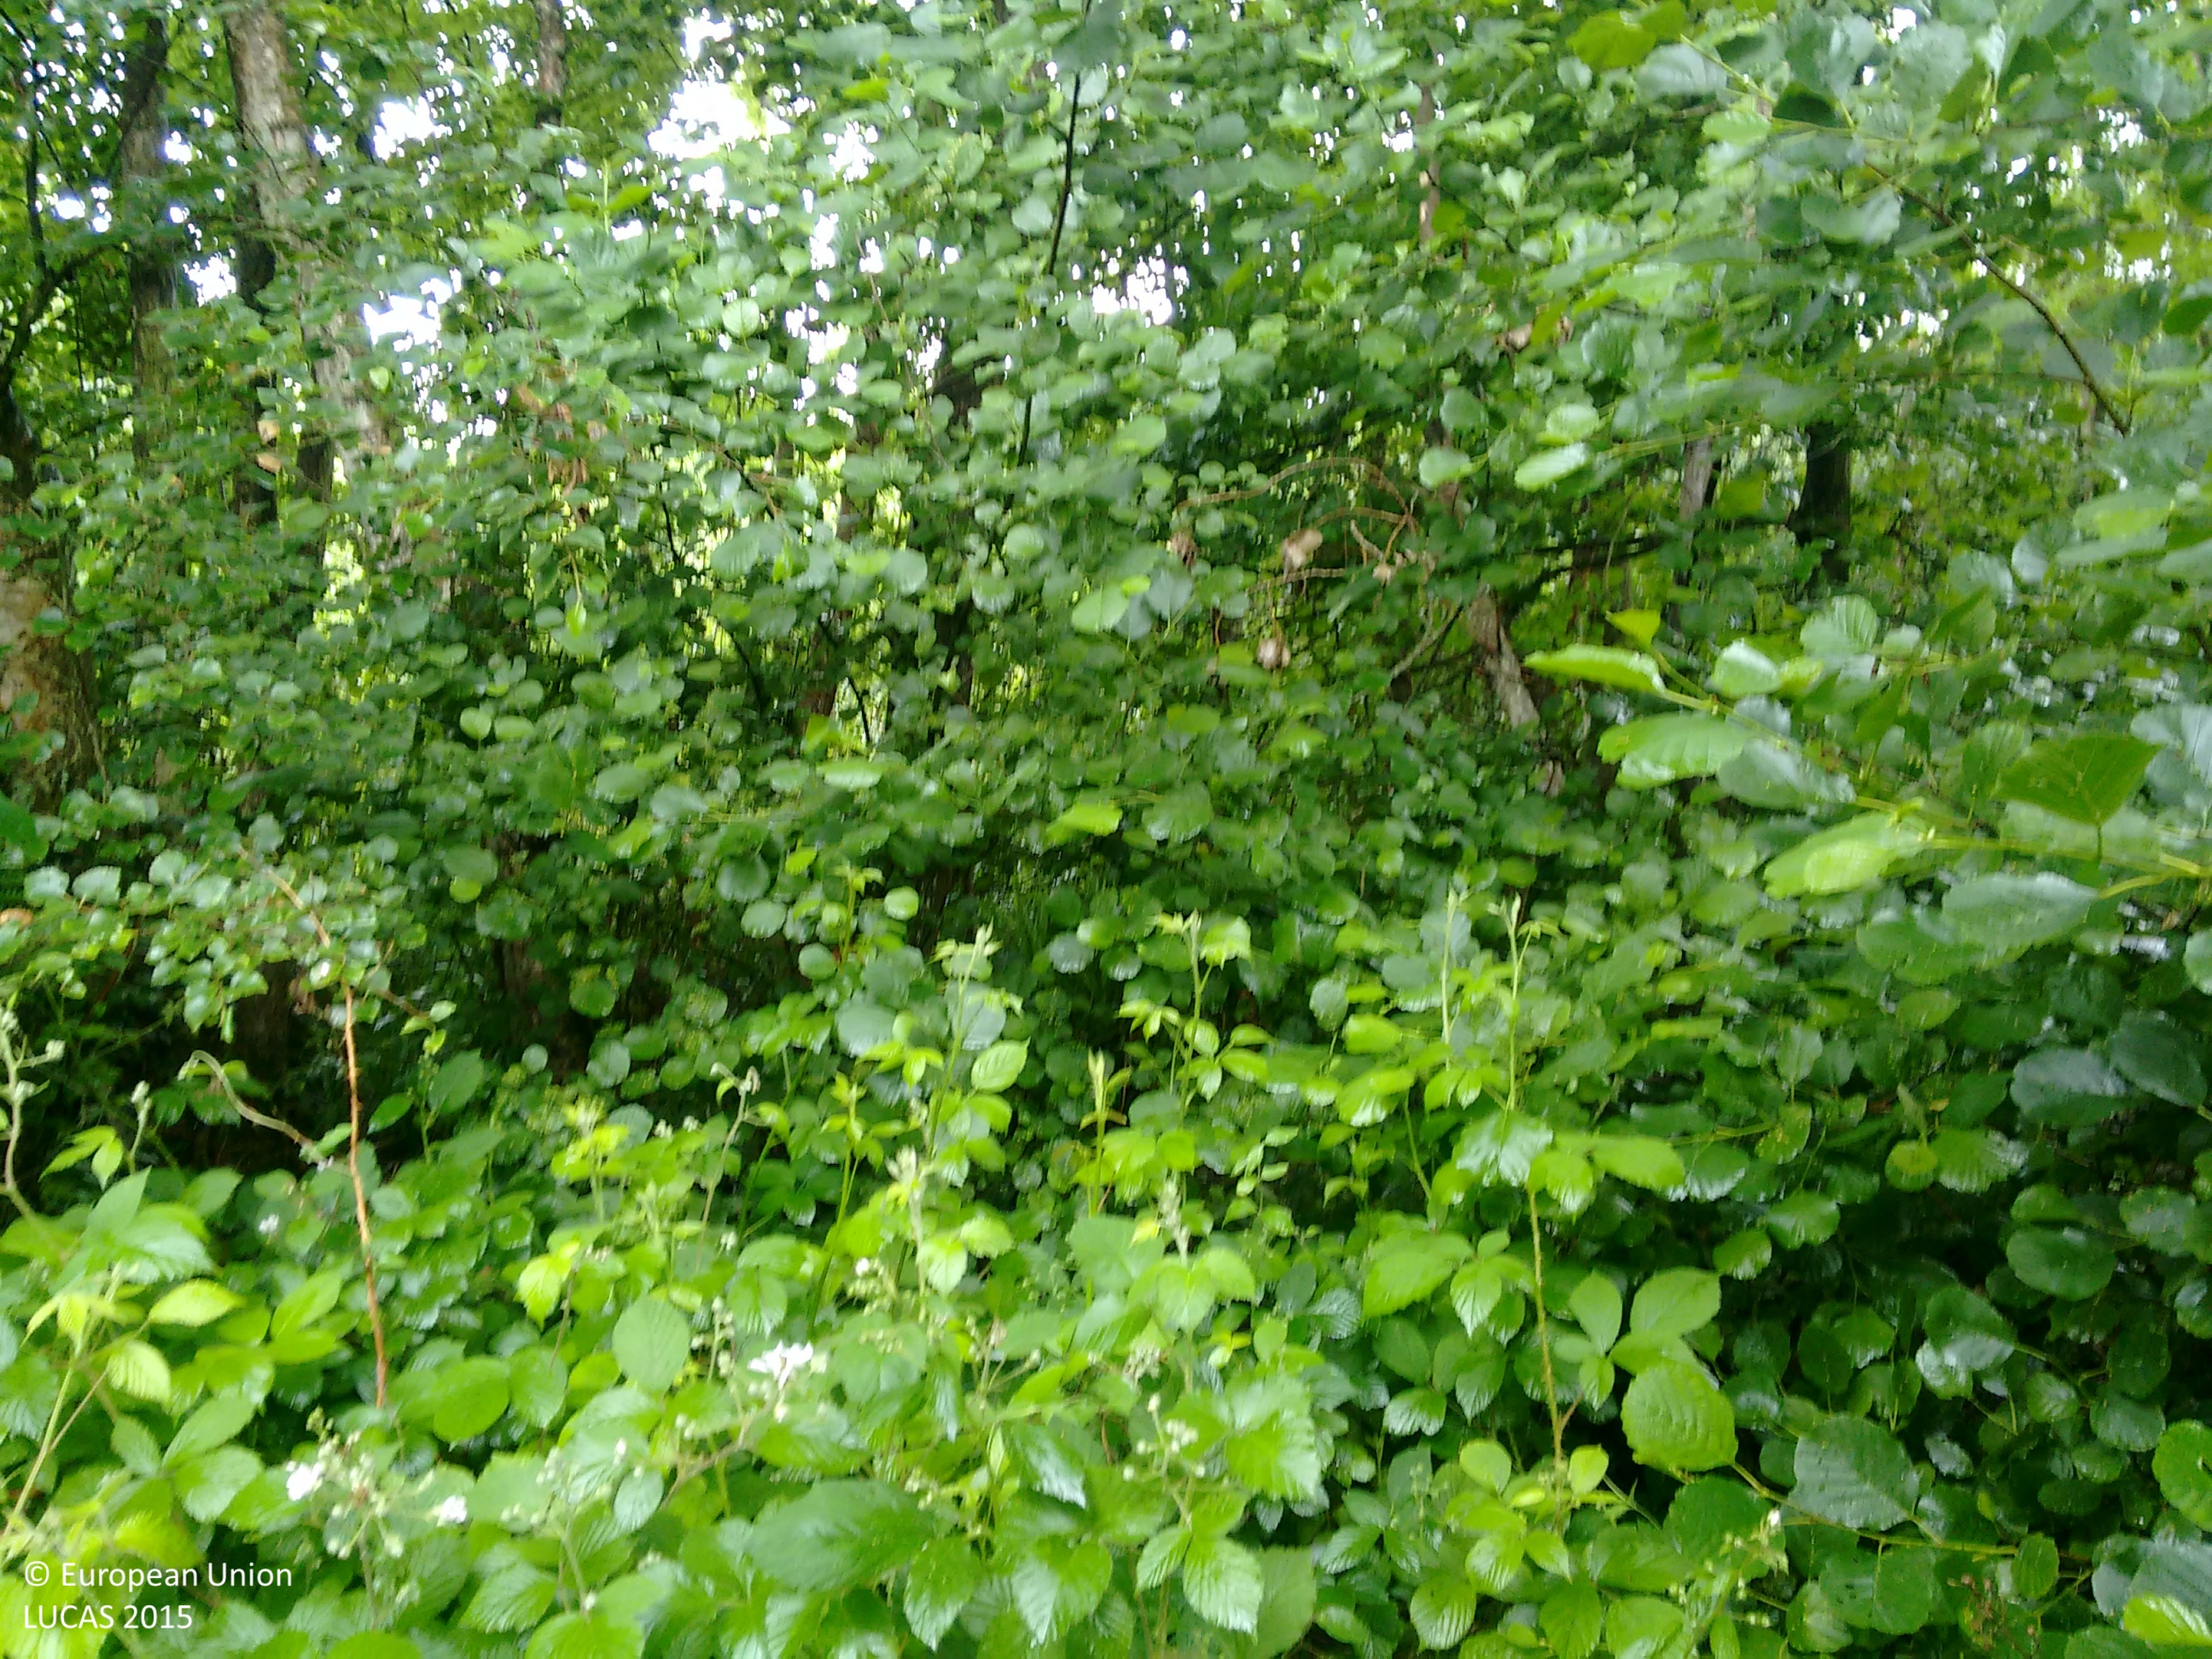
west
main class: Woodland
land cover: Broadleaved woodland
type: mesophytic deciduous forest
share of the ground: > 75 %
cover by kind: broadleaved forest trees 70 %, shrubs 30 %
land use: Forestry
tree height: > 5 m
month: June
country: GB
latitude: 50.8858
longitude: 0.4335
